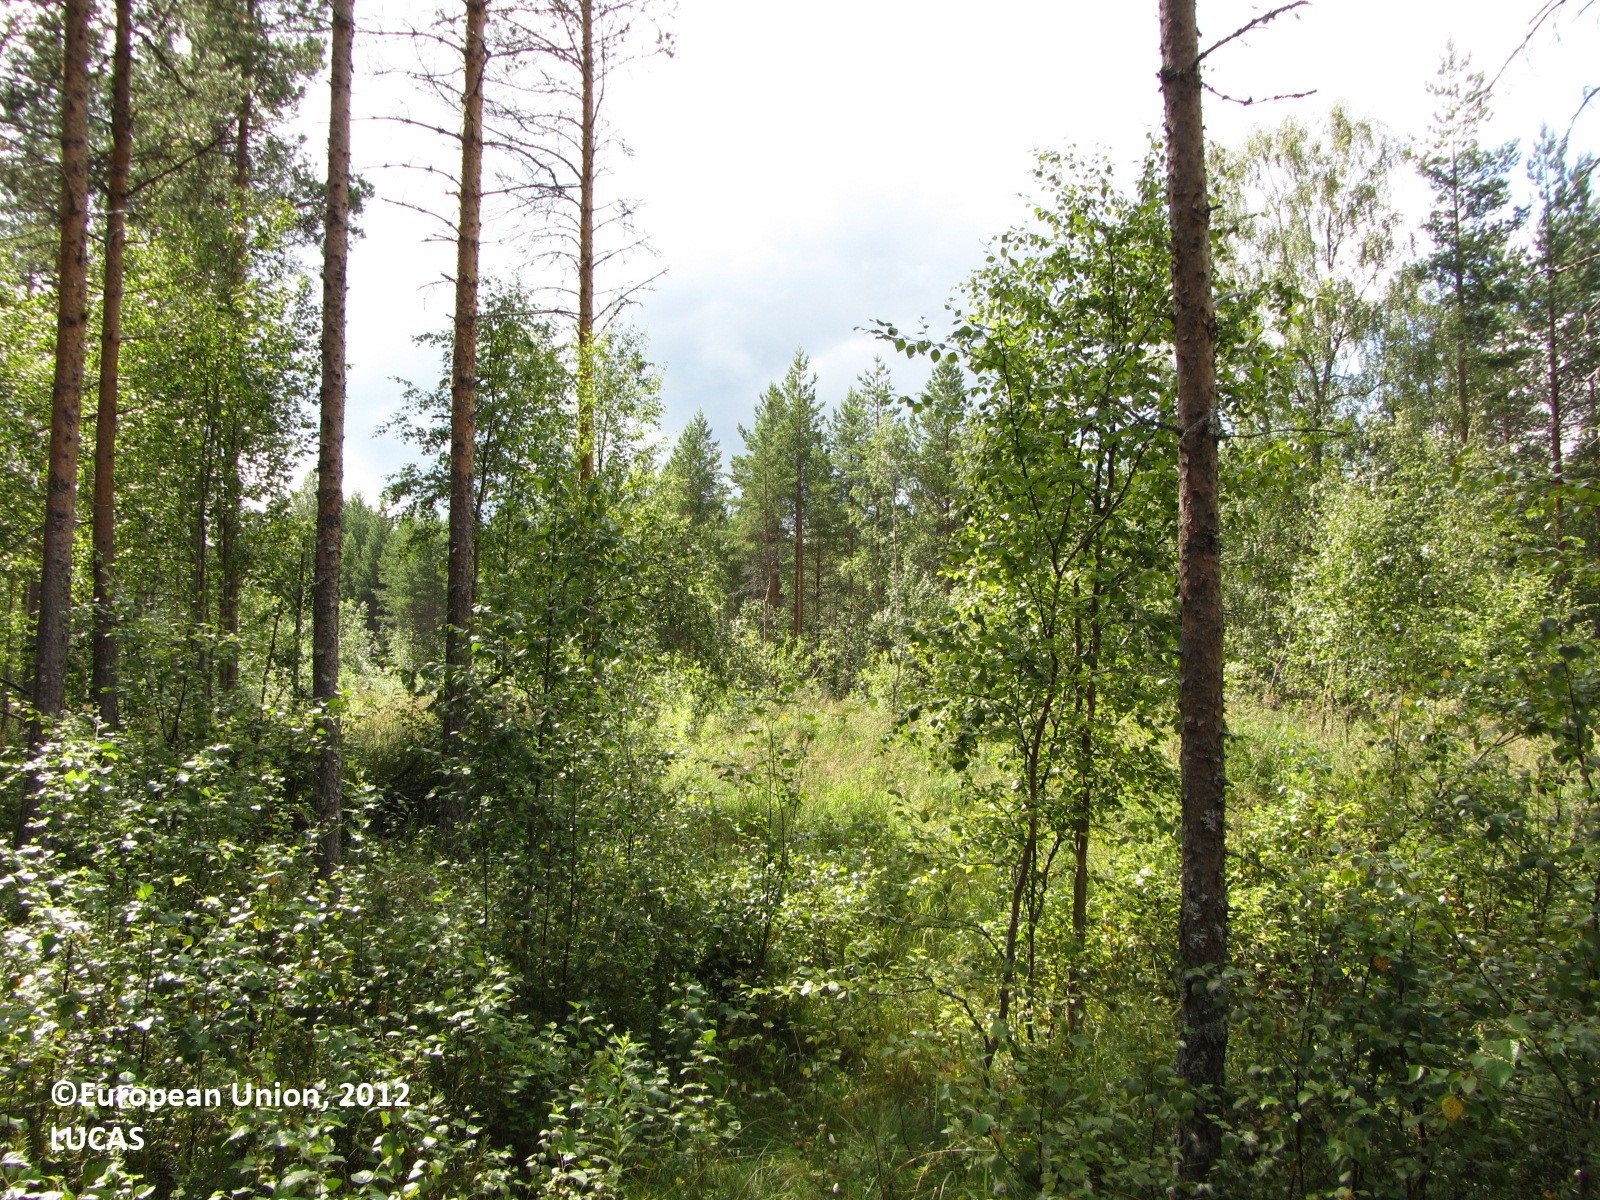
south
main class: Woodland
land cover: Pine dominated mixed woodland
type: boreal forest
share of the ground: 50 - 75 %
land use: Forestry
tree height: > 5 m
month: July
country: FI
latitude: 63.6445
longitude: 24.5968
